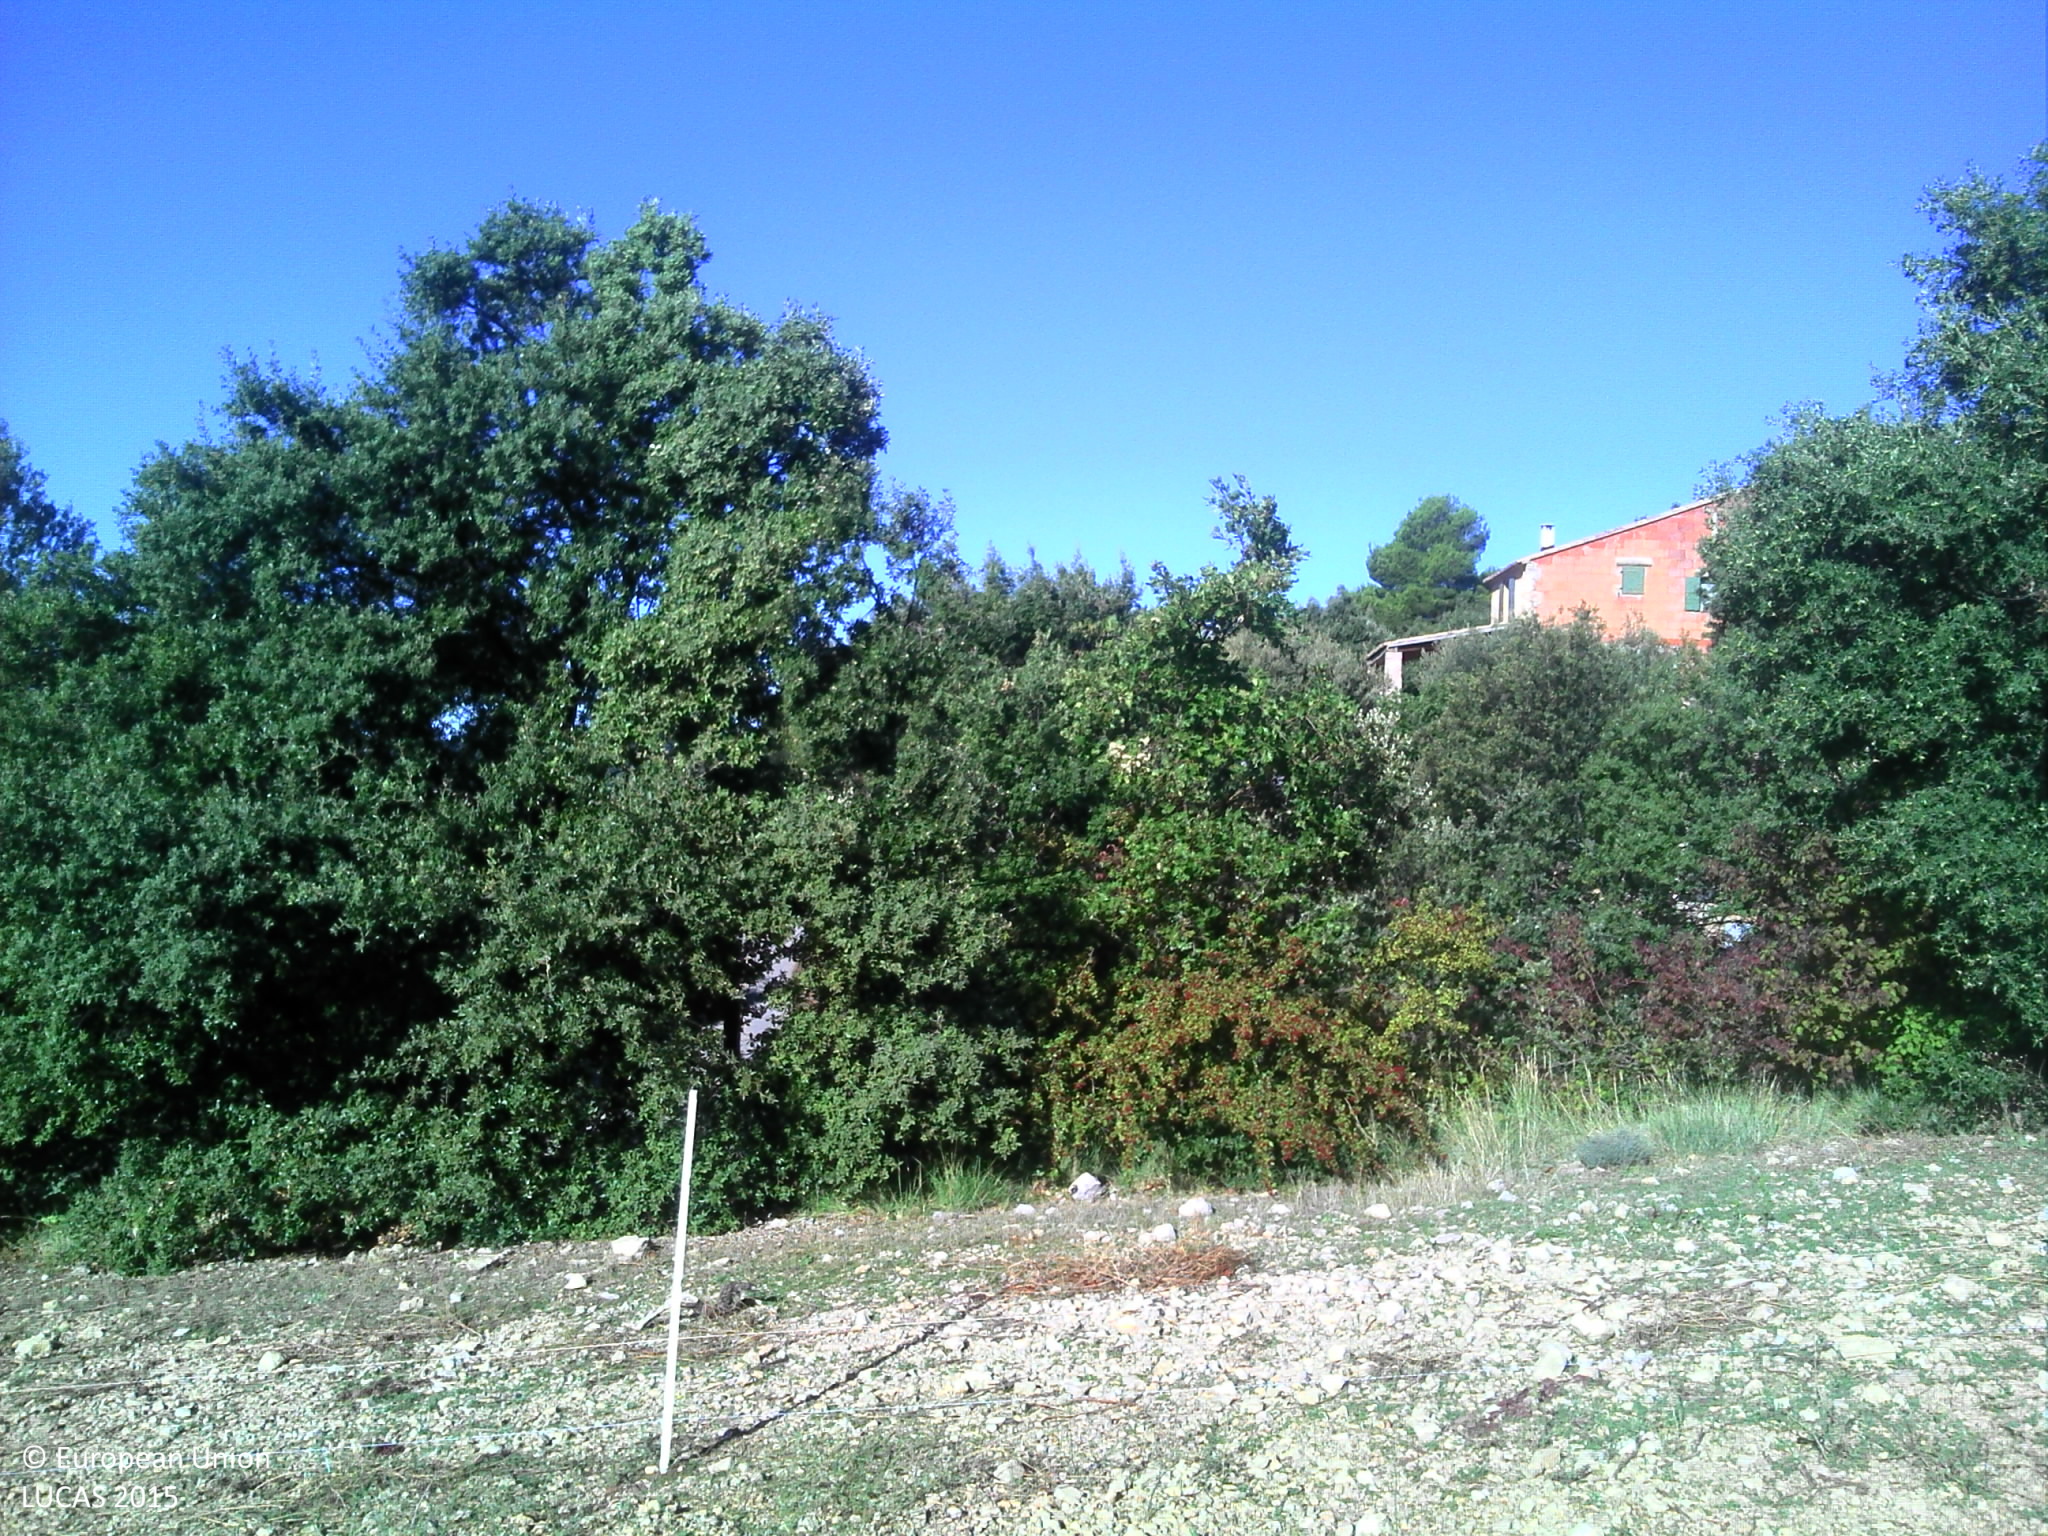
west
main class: Cropland
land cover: Vineyards
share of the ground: 25 - 50 %
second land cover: Other bare soil
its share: > 75 %
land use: Agriculture (excluding fallow land and kitchen gardens)
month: September
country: FR
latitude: 44.2952
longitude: 5.2324
